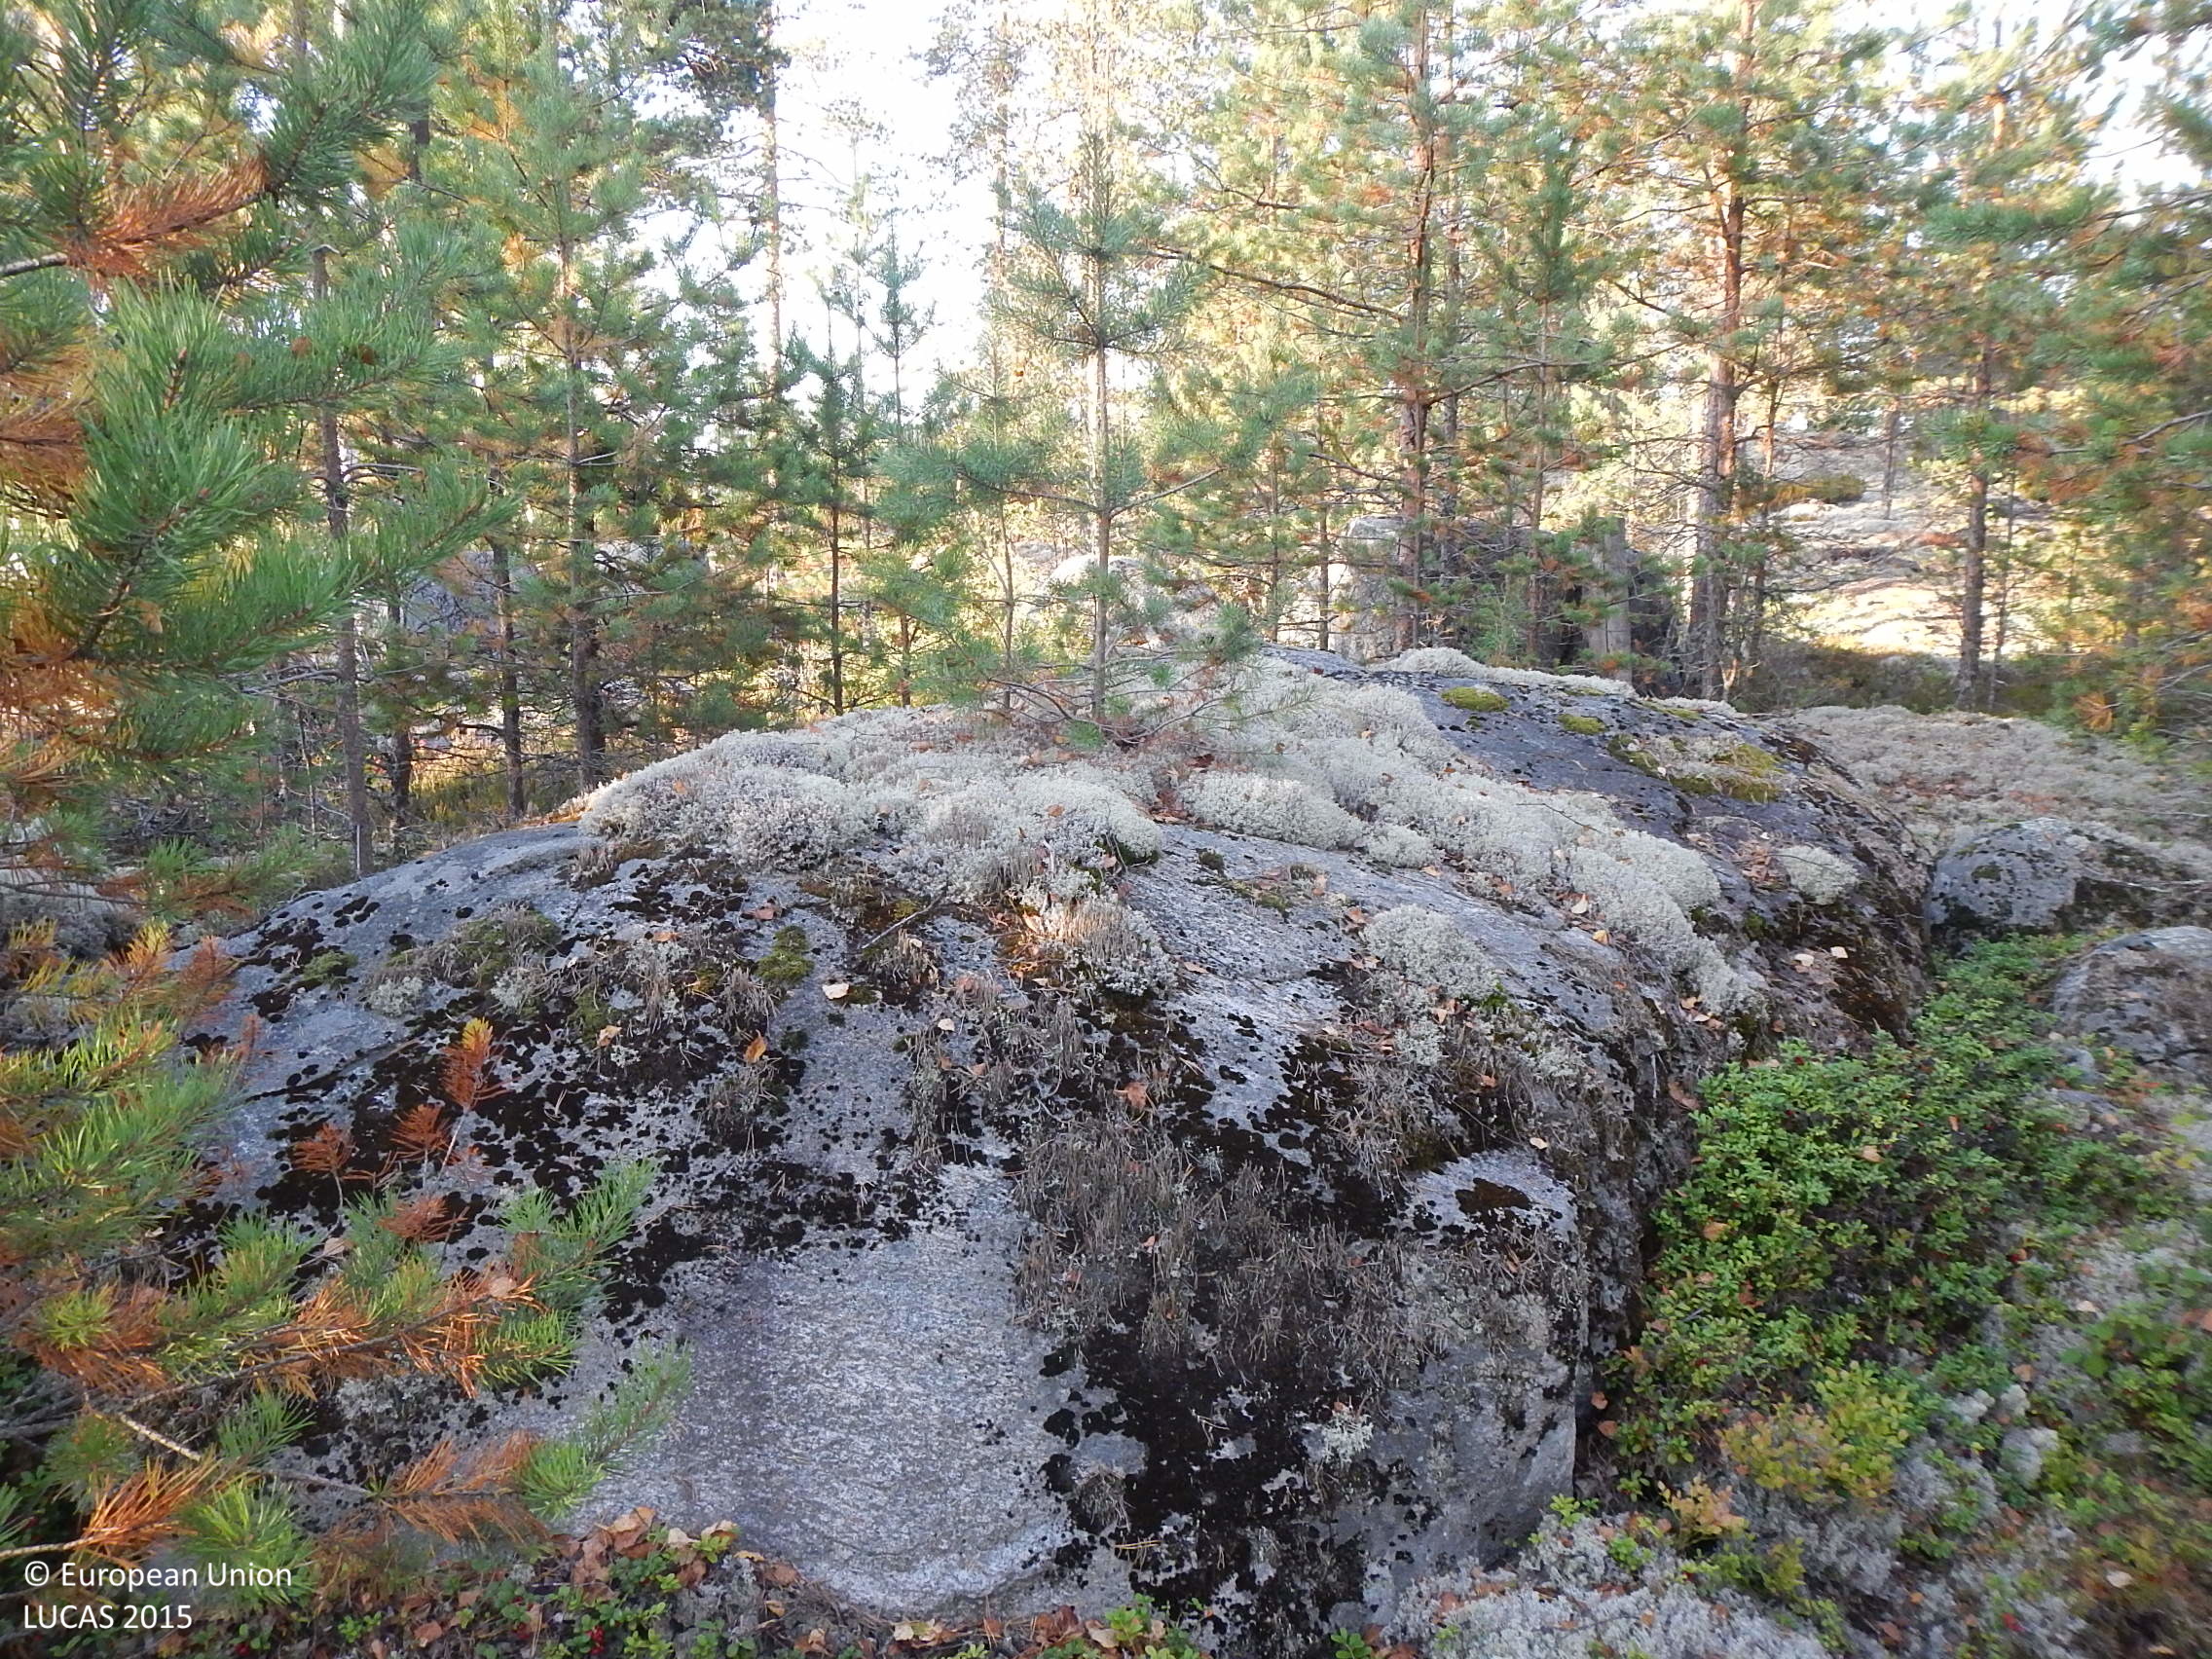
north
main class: Woodland
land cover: Pine dominated coniferous woodland
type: boreal forest
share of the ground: 25 - 50 %
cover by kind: coniferous forest trees 40 %, lichens and mosses 30 %, shrubs 15 %, consolidated bare surface 10 %, broadleaved forest trees 5 %
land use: Forestry
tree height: > 5 m
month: September
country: FI
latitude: 61.5511
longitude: 22.1580
